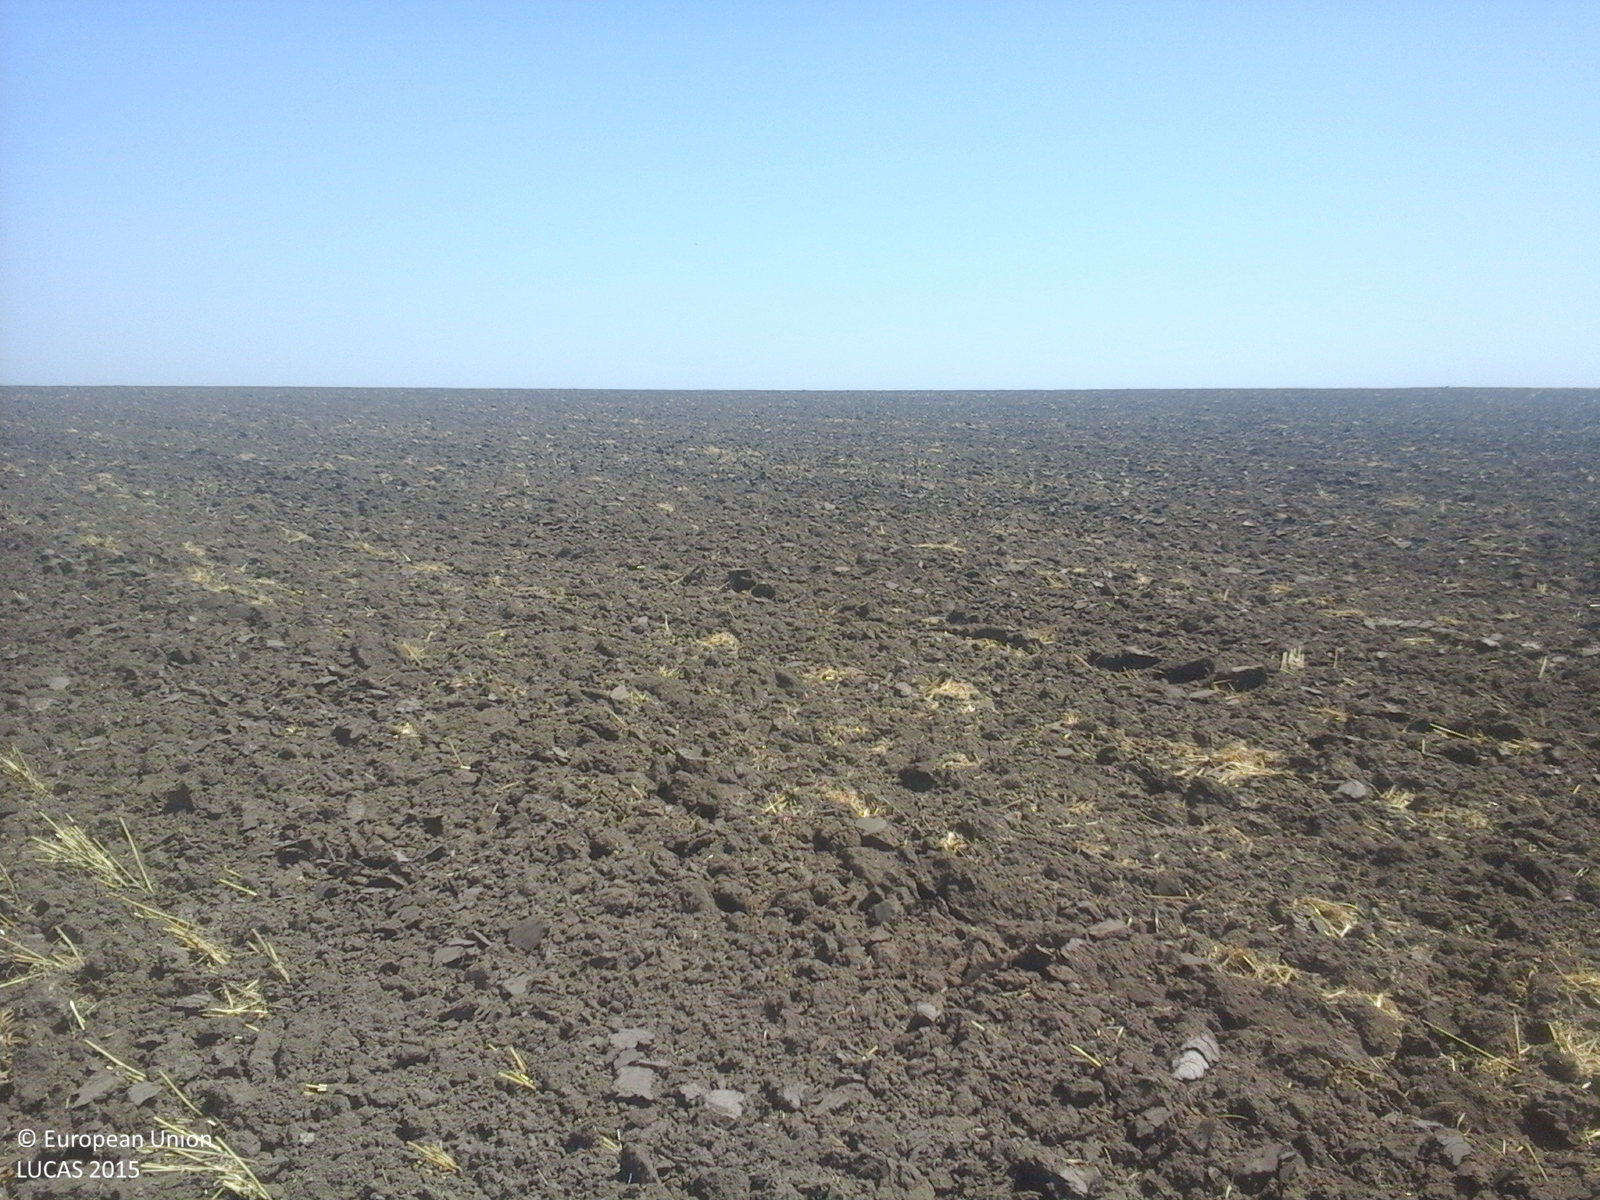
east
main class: Cropland
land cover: Durum wheat
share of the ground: < 10 %
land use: Agriculture (excluding fallow land and kitchen gardens)
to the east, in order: Durum wheat
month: July
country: RO
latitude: 44.4395
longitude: 26.6919
